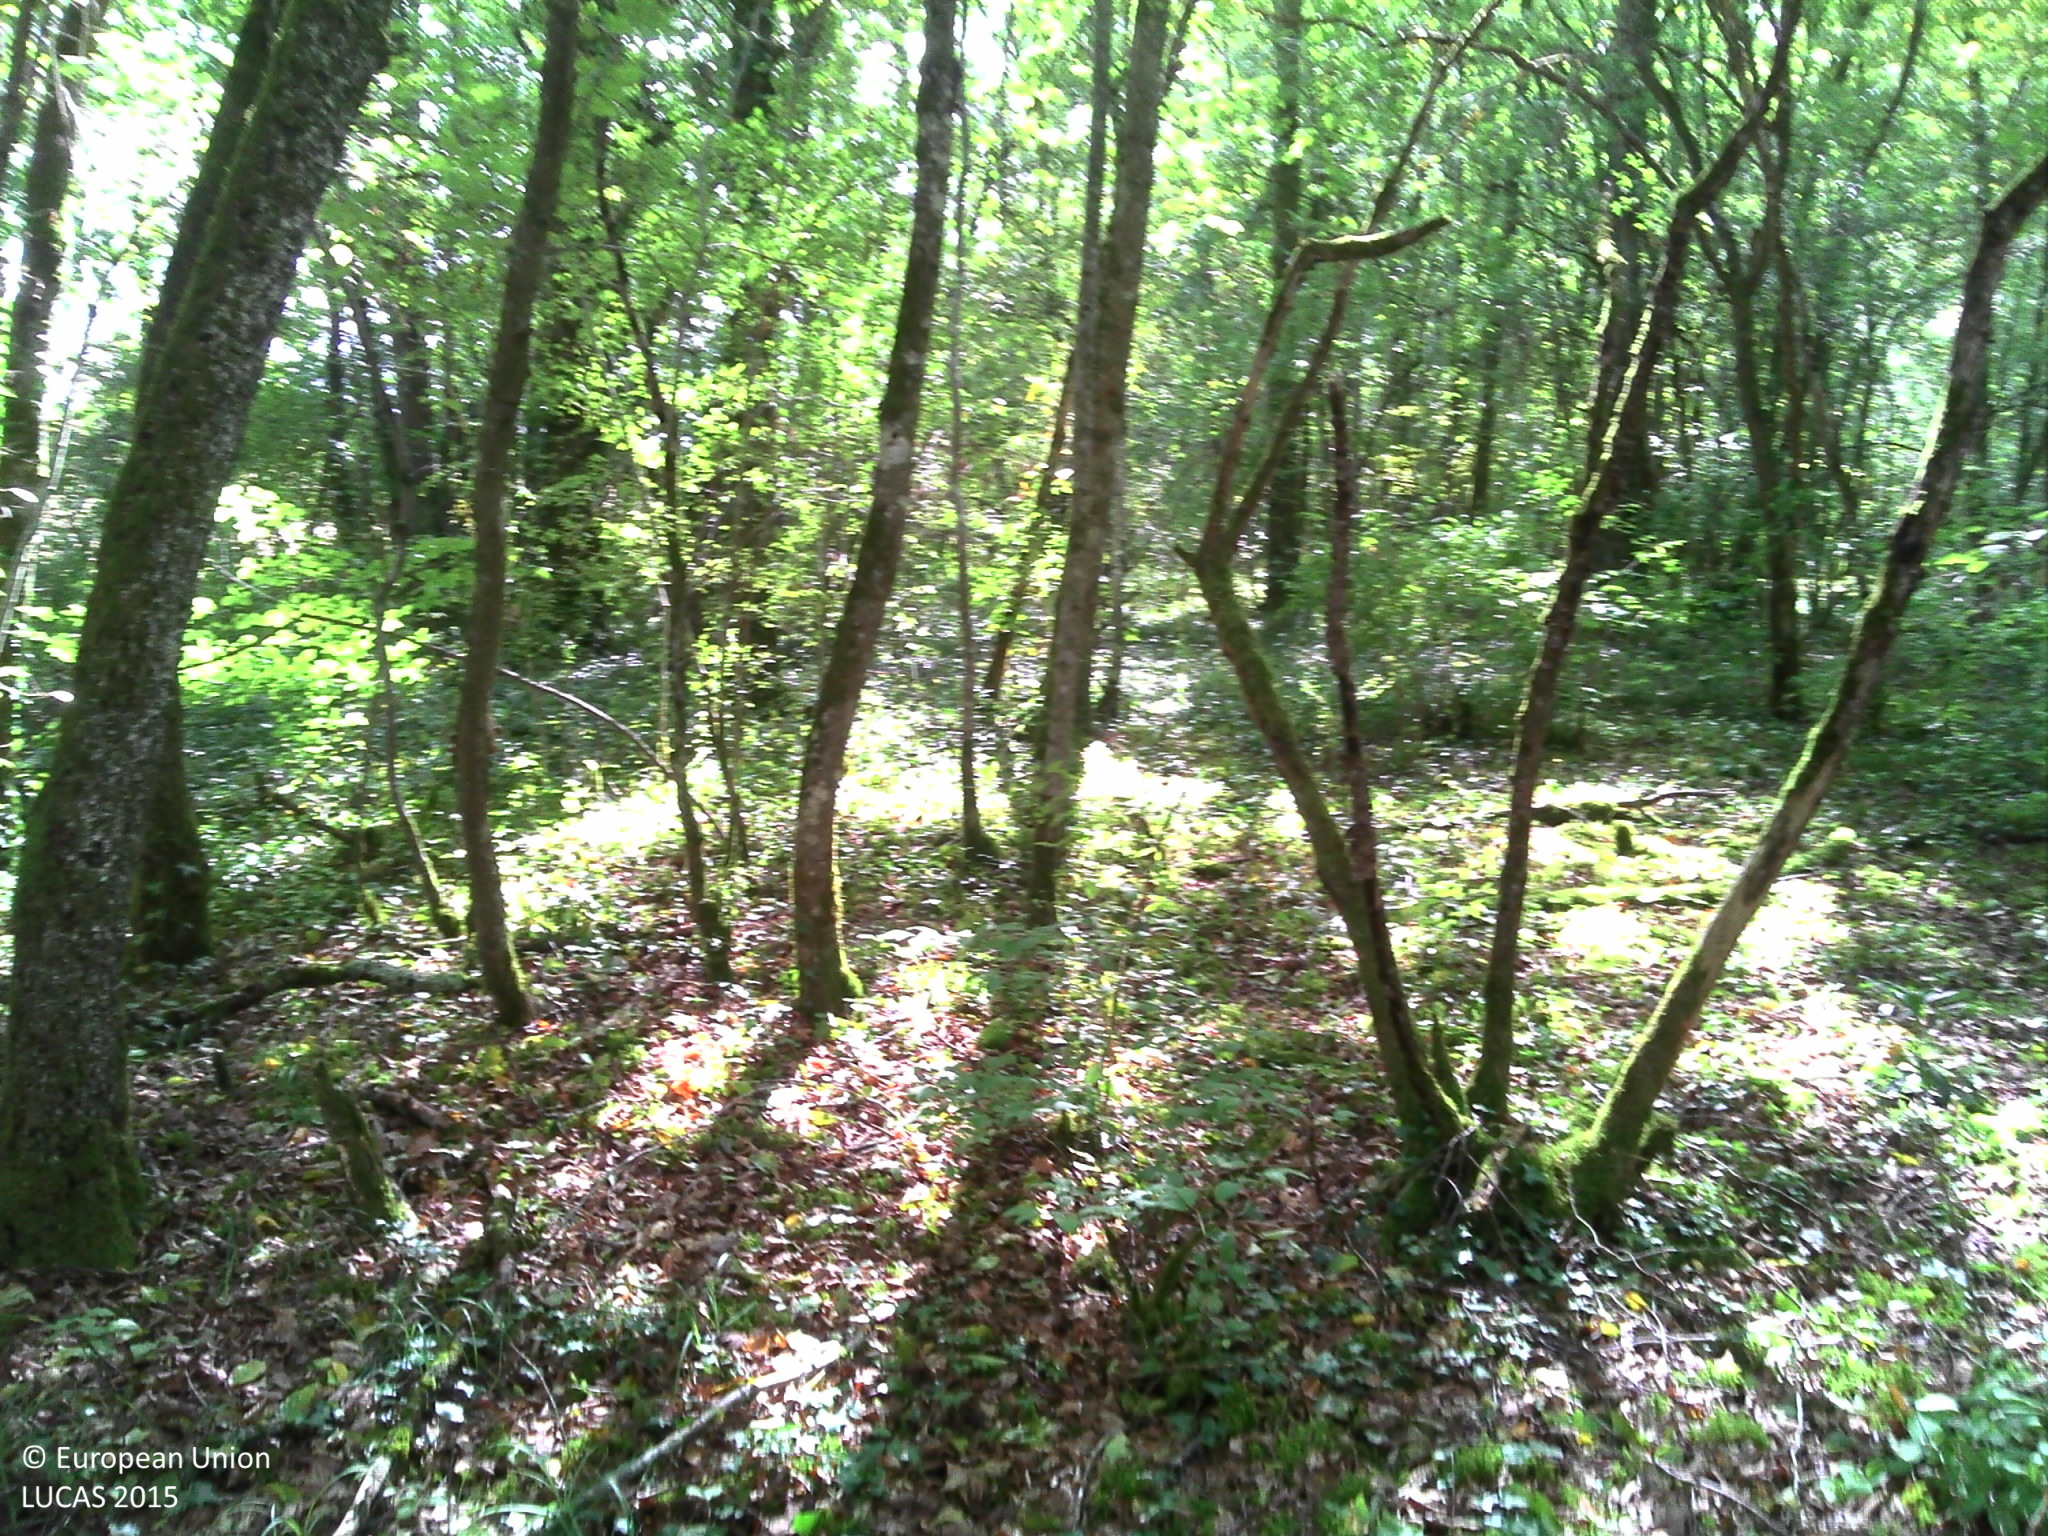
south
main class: Woodland
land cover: Broadleaved woodland
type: mesophytic deciduous forest
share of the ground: > 75 %
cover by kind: broadleaved forest trees 90 %, herbaceous plants 5 %, lichens and mosses 5 %
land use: Forestry
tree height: > 5 m
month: September
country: FR
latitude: 48.0205
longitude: 4.2723
